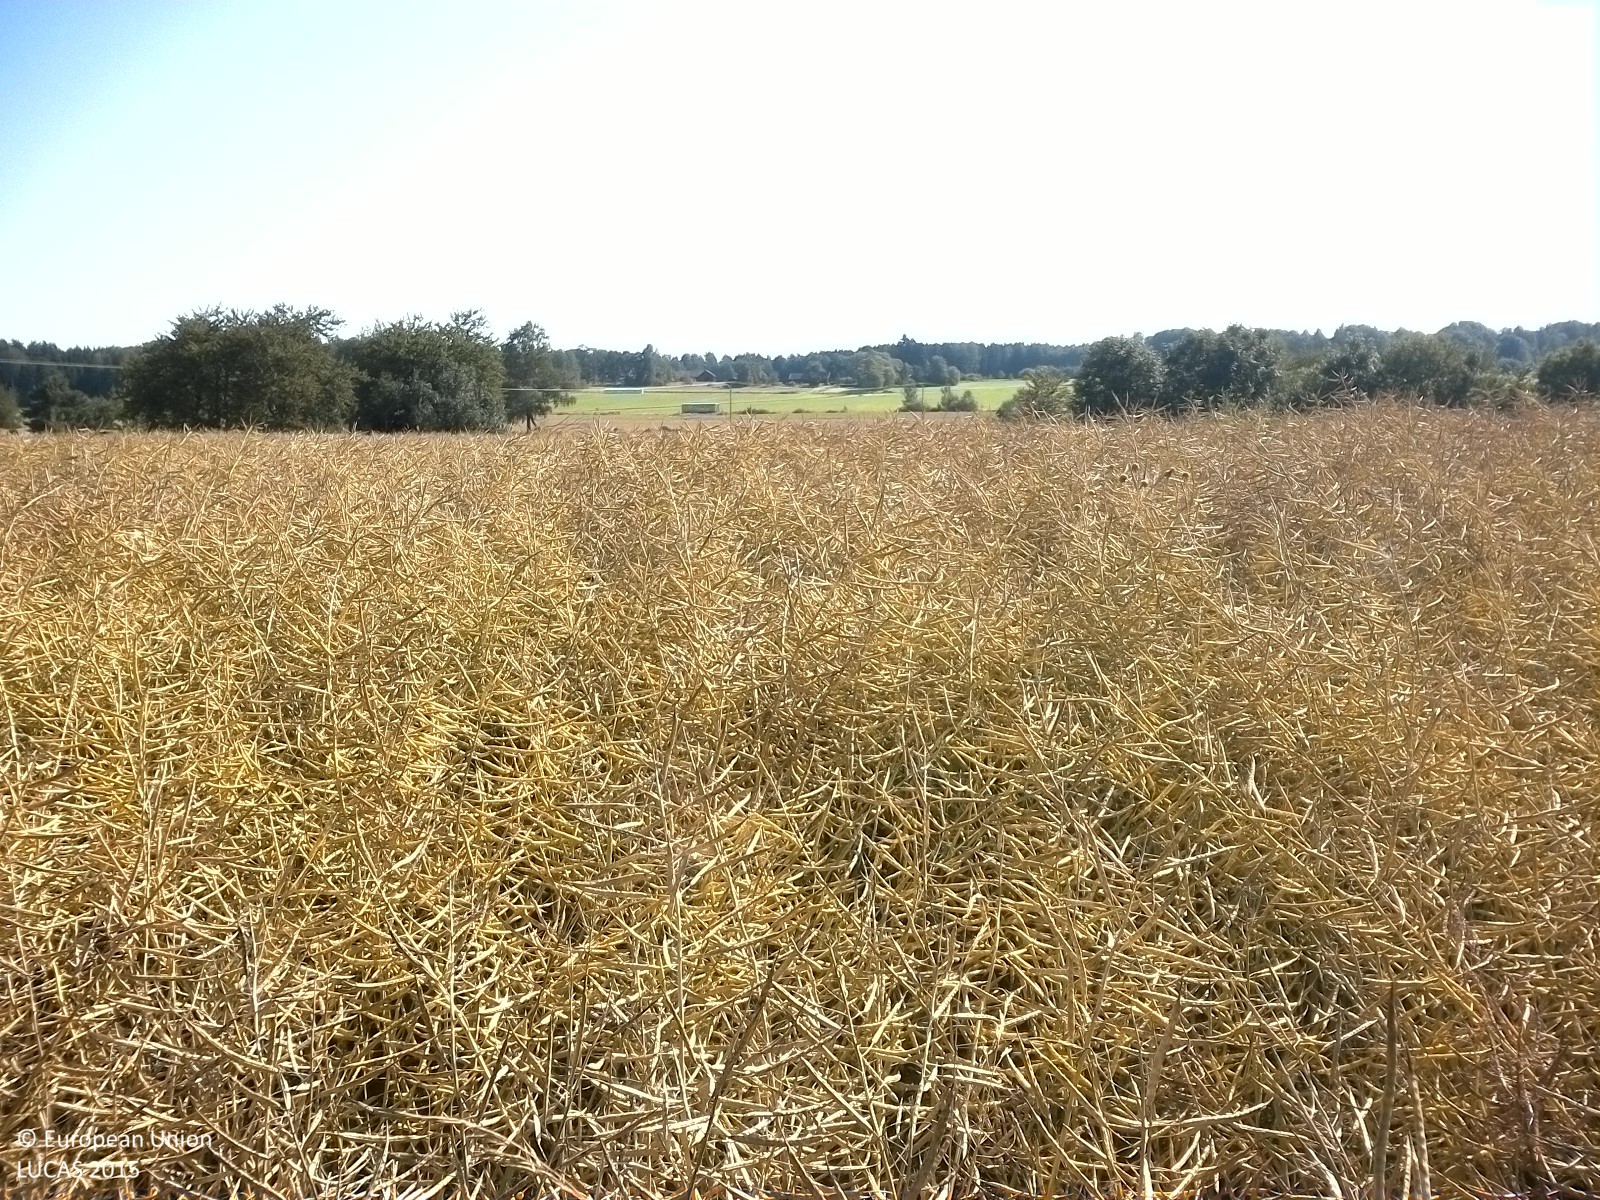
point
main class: Cropland
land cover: Rape and turnip rape
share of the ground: > 75 %
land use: Agriculture (excluding fallow land and kitchen gardens)
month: August
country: SE
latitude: 59.0497
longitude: 15.3791
